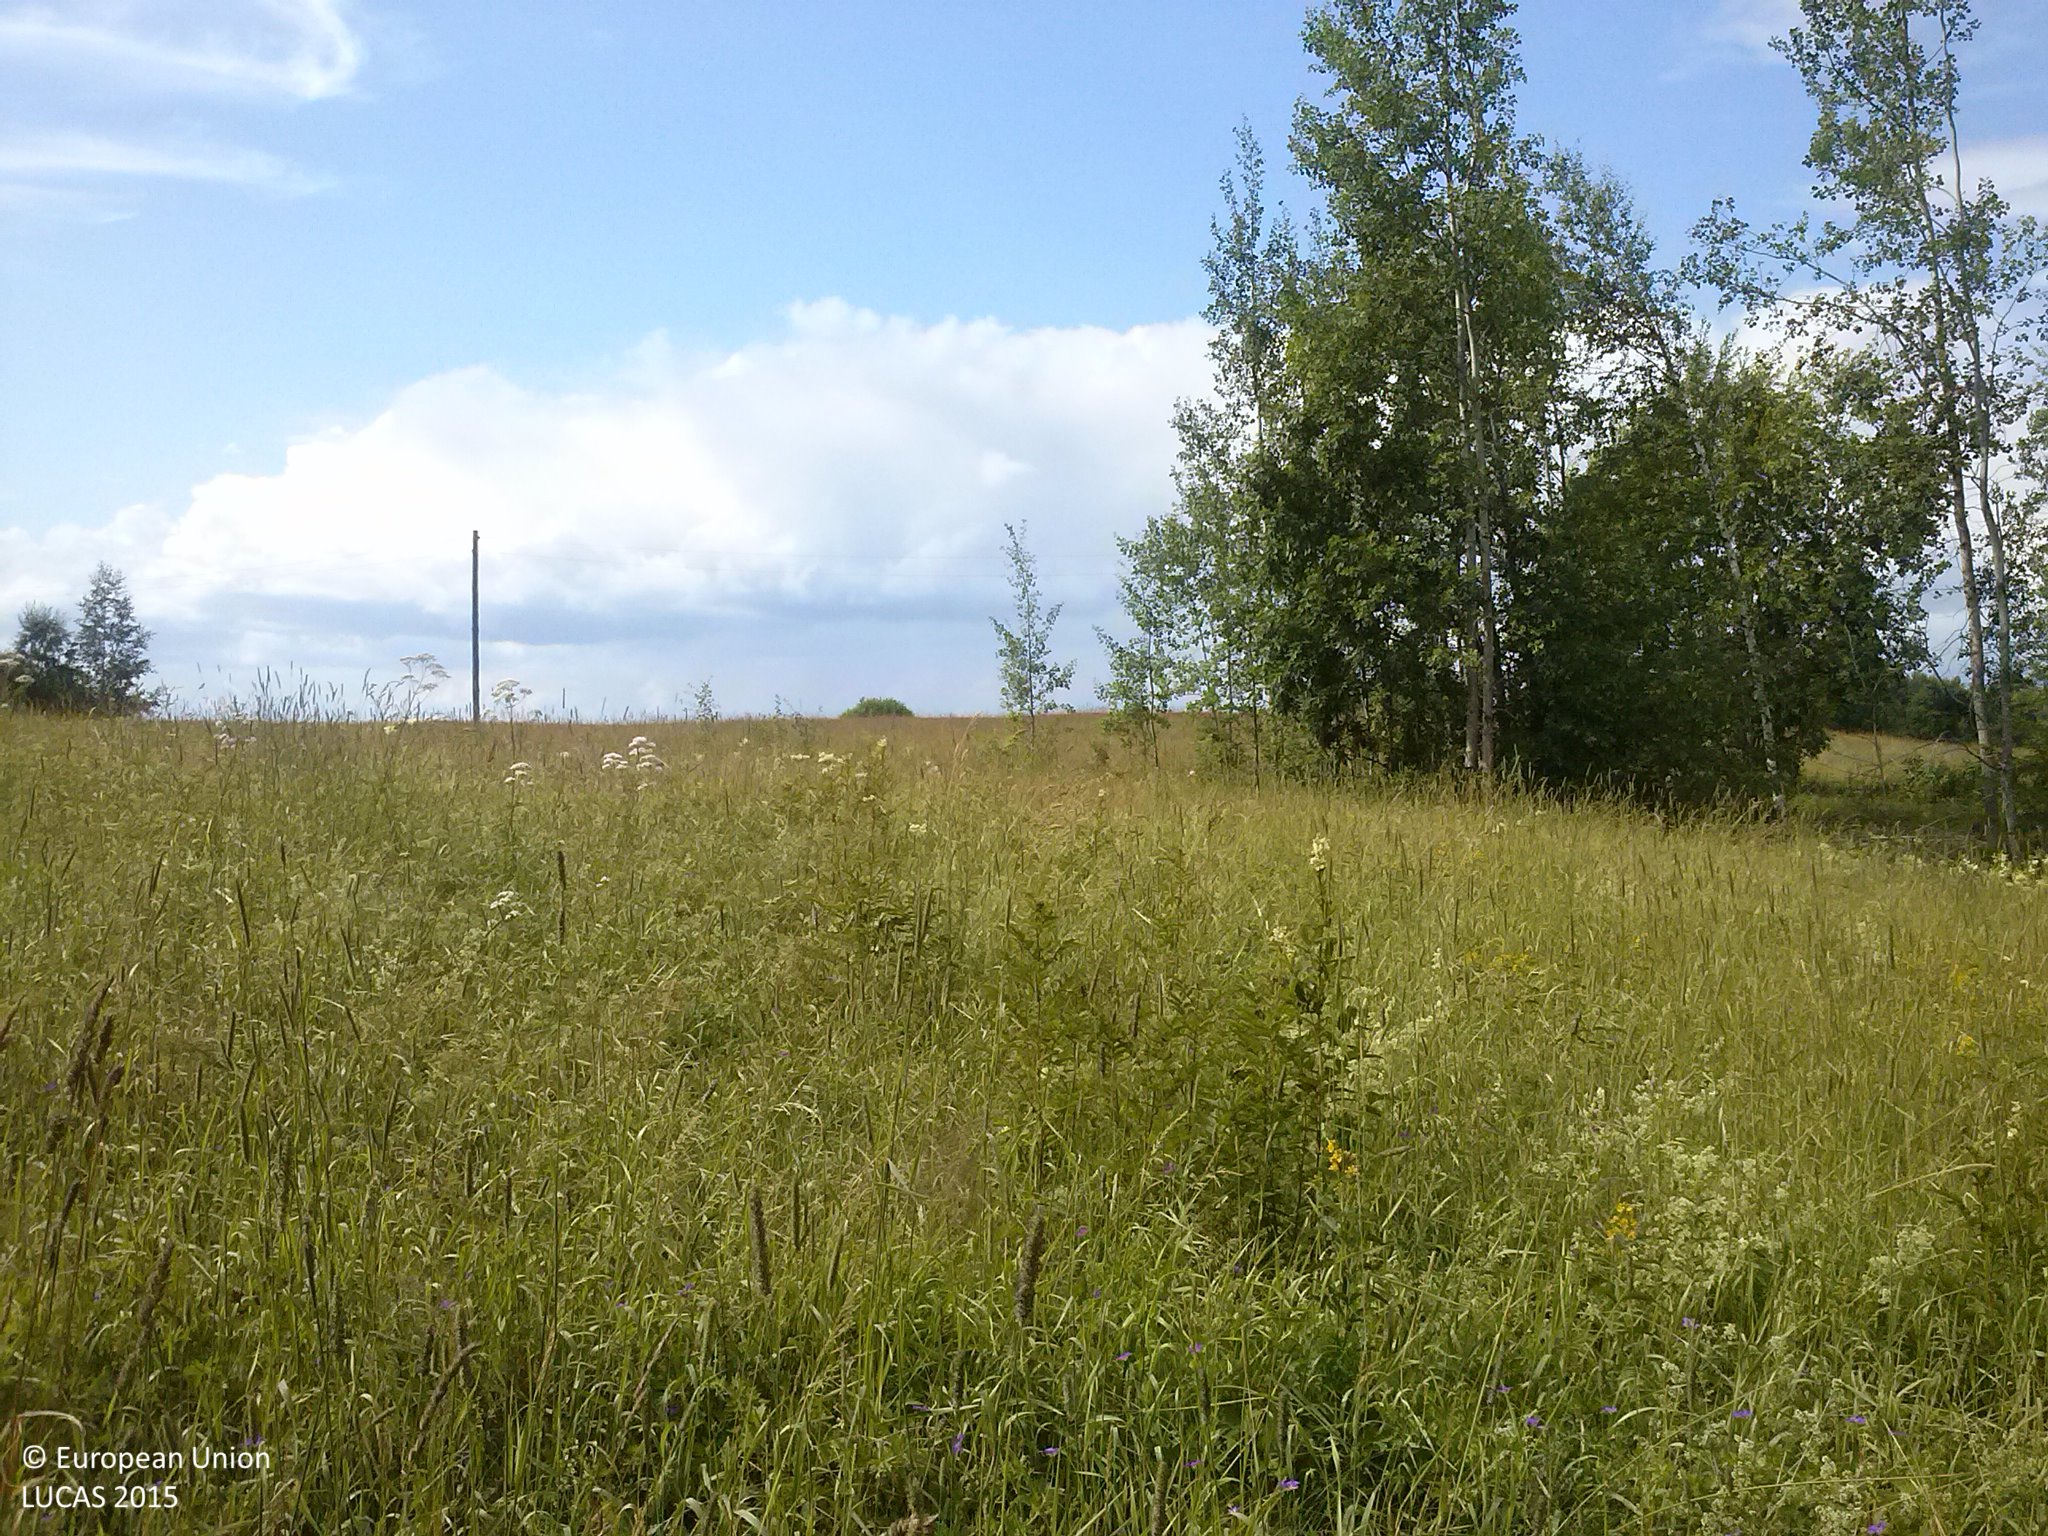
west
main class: Grassland
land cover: Grassland without tree/shrub cover
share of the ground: > 75 %
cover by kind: herbaceous plants 100 %
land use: Agriculture (excluding fallow land and kitchen gardens)
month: July
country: LV
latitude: 56.6394
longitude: 27.3091
